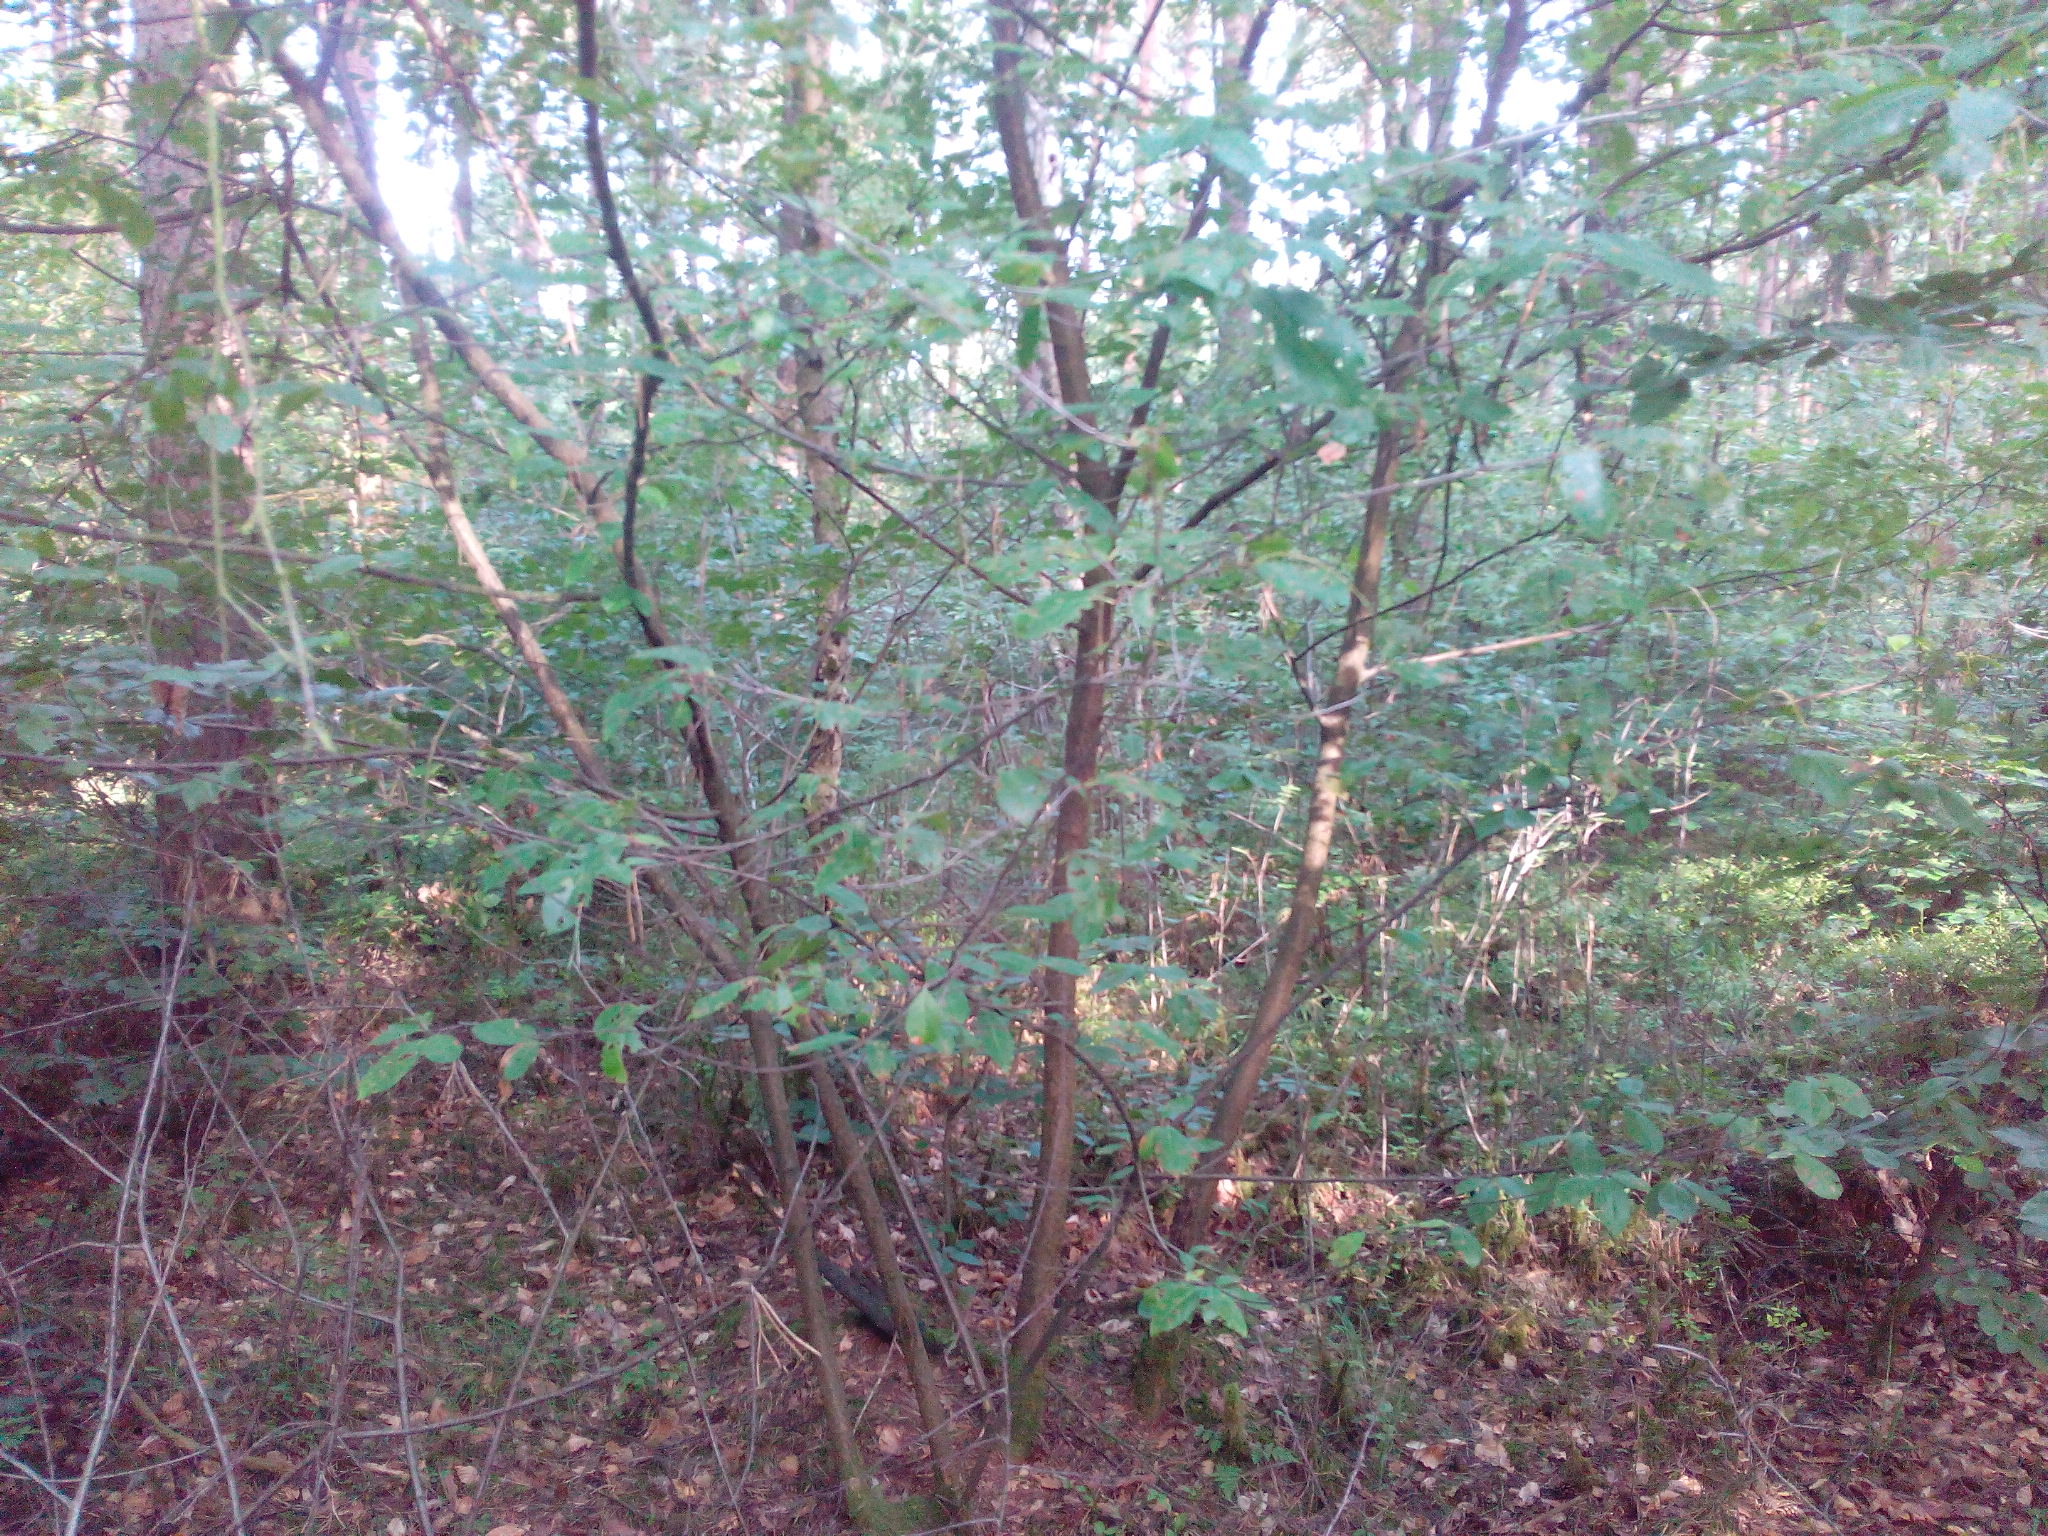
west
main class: Woodland
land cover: Pine dominated mixed woodland
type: hemiboreal forest and nemoral coniferous forest and mixed broadleaved-coniferous forest
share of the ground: > 75 %
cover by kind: coniferous forest trees 45 %, broadleaved forest trees 45 %, shrubs 5 %, herbaceous plants 5 %
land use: Forestry
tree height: > 5 m
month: August
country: DE
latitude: 52.5752
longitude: 9.9262
